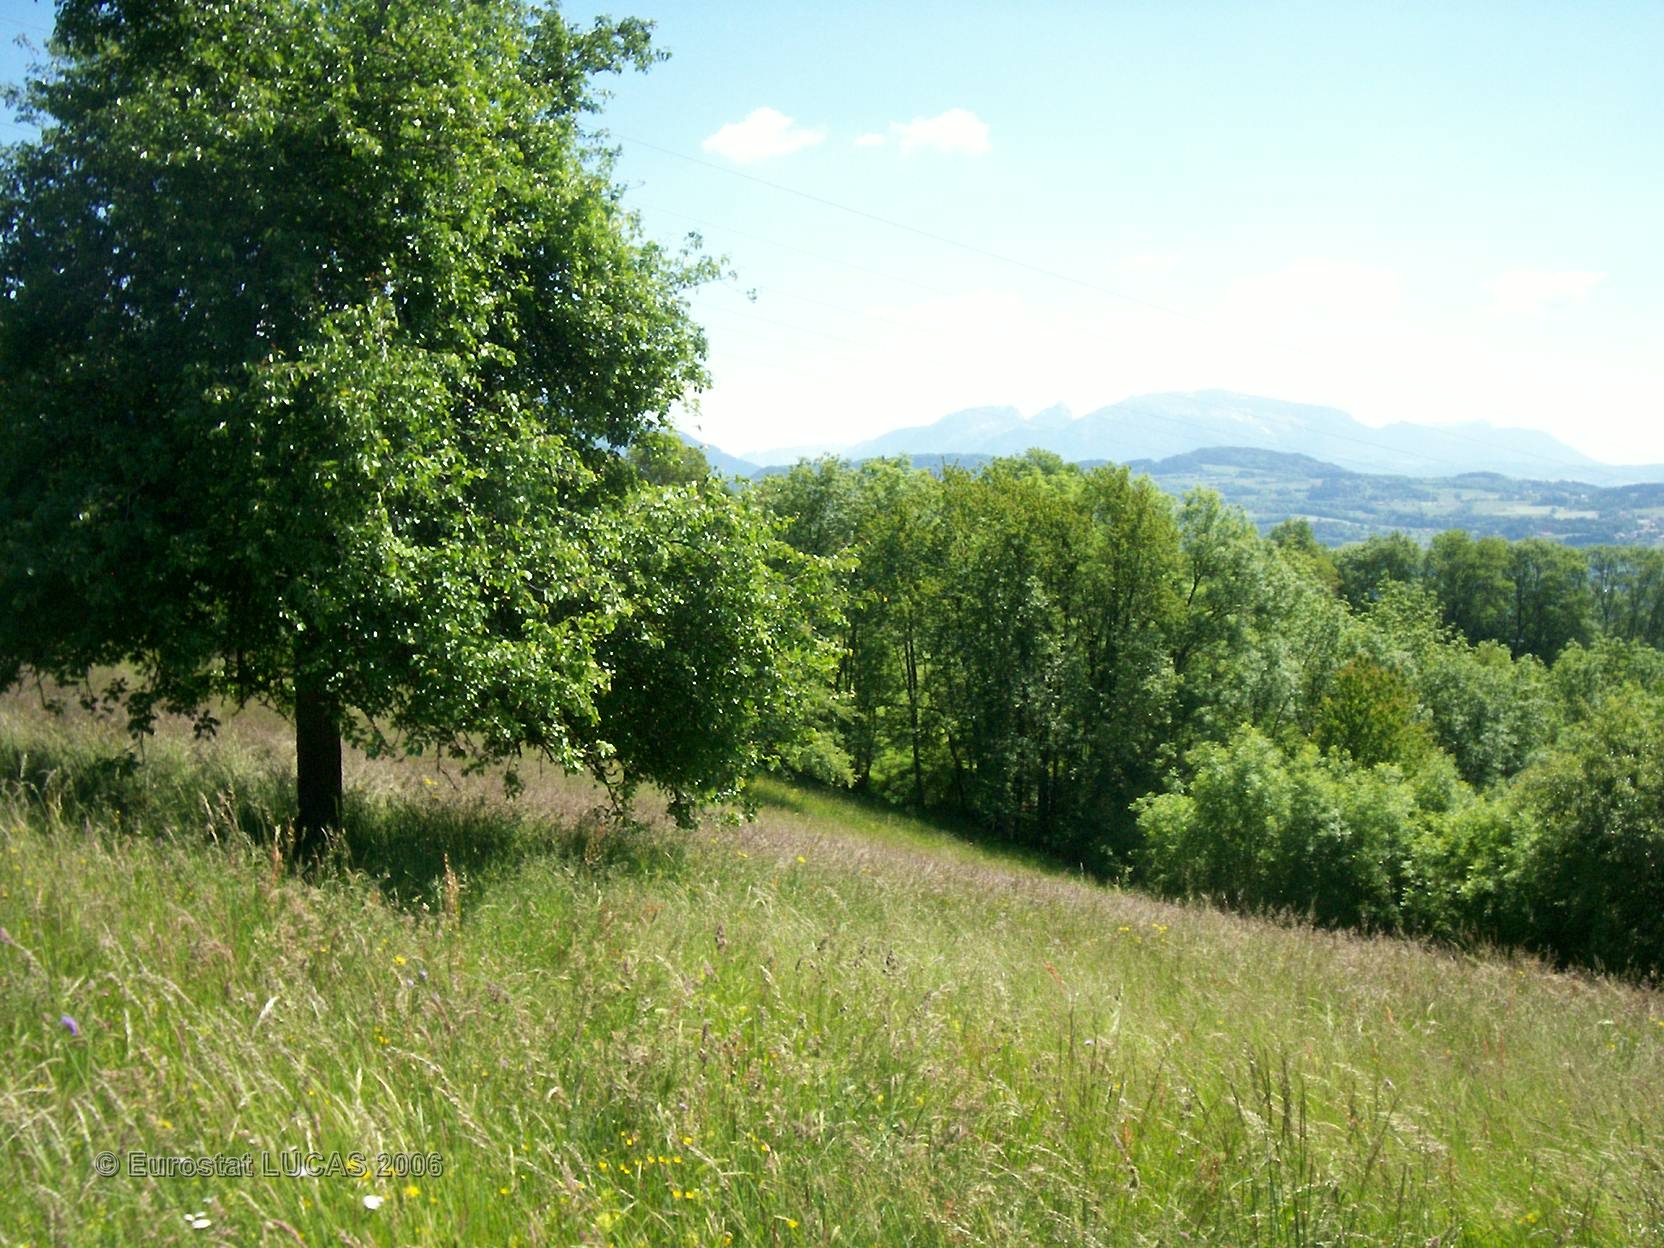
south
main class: Grassland
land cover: Grassland with sparse tree/shrub cover
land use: Agriculture (excluding fallow land and kitchen gardens)
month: June
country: FR
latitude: 46.1650
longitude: 6.4161
